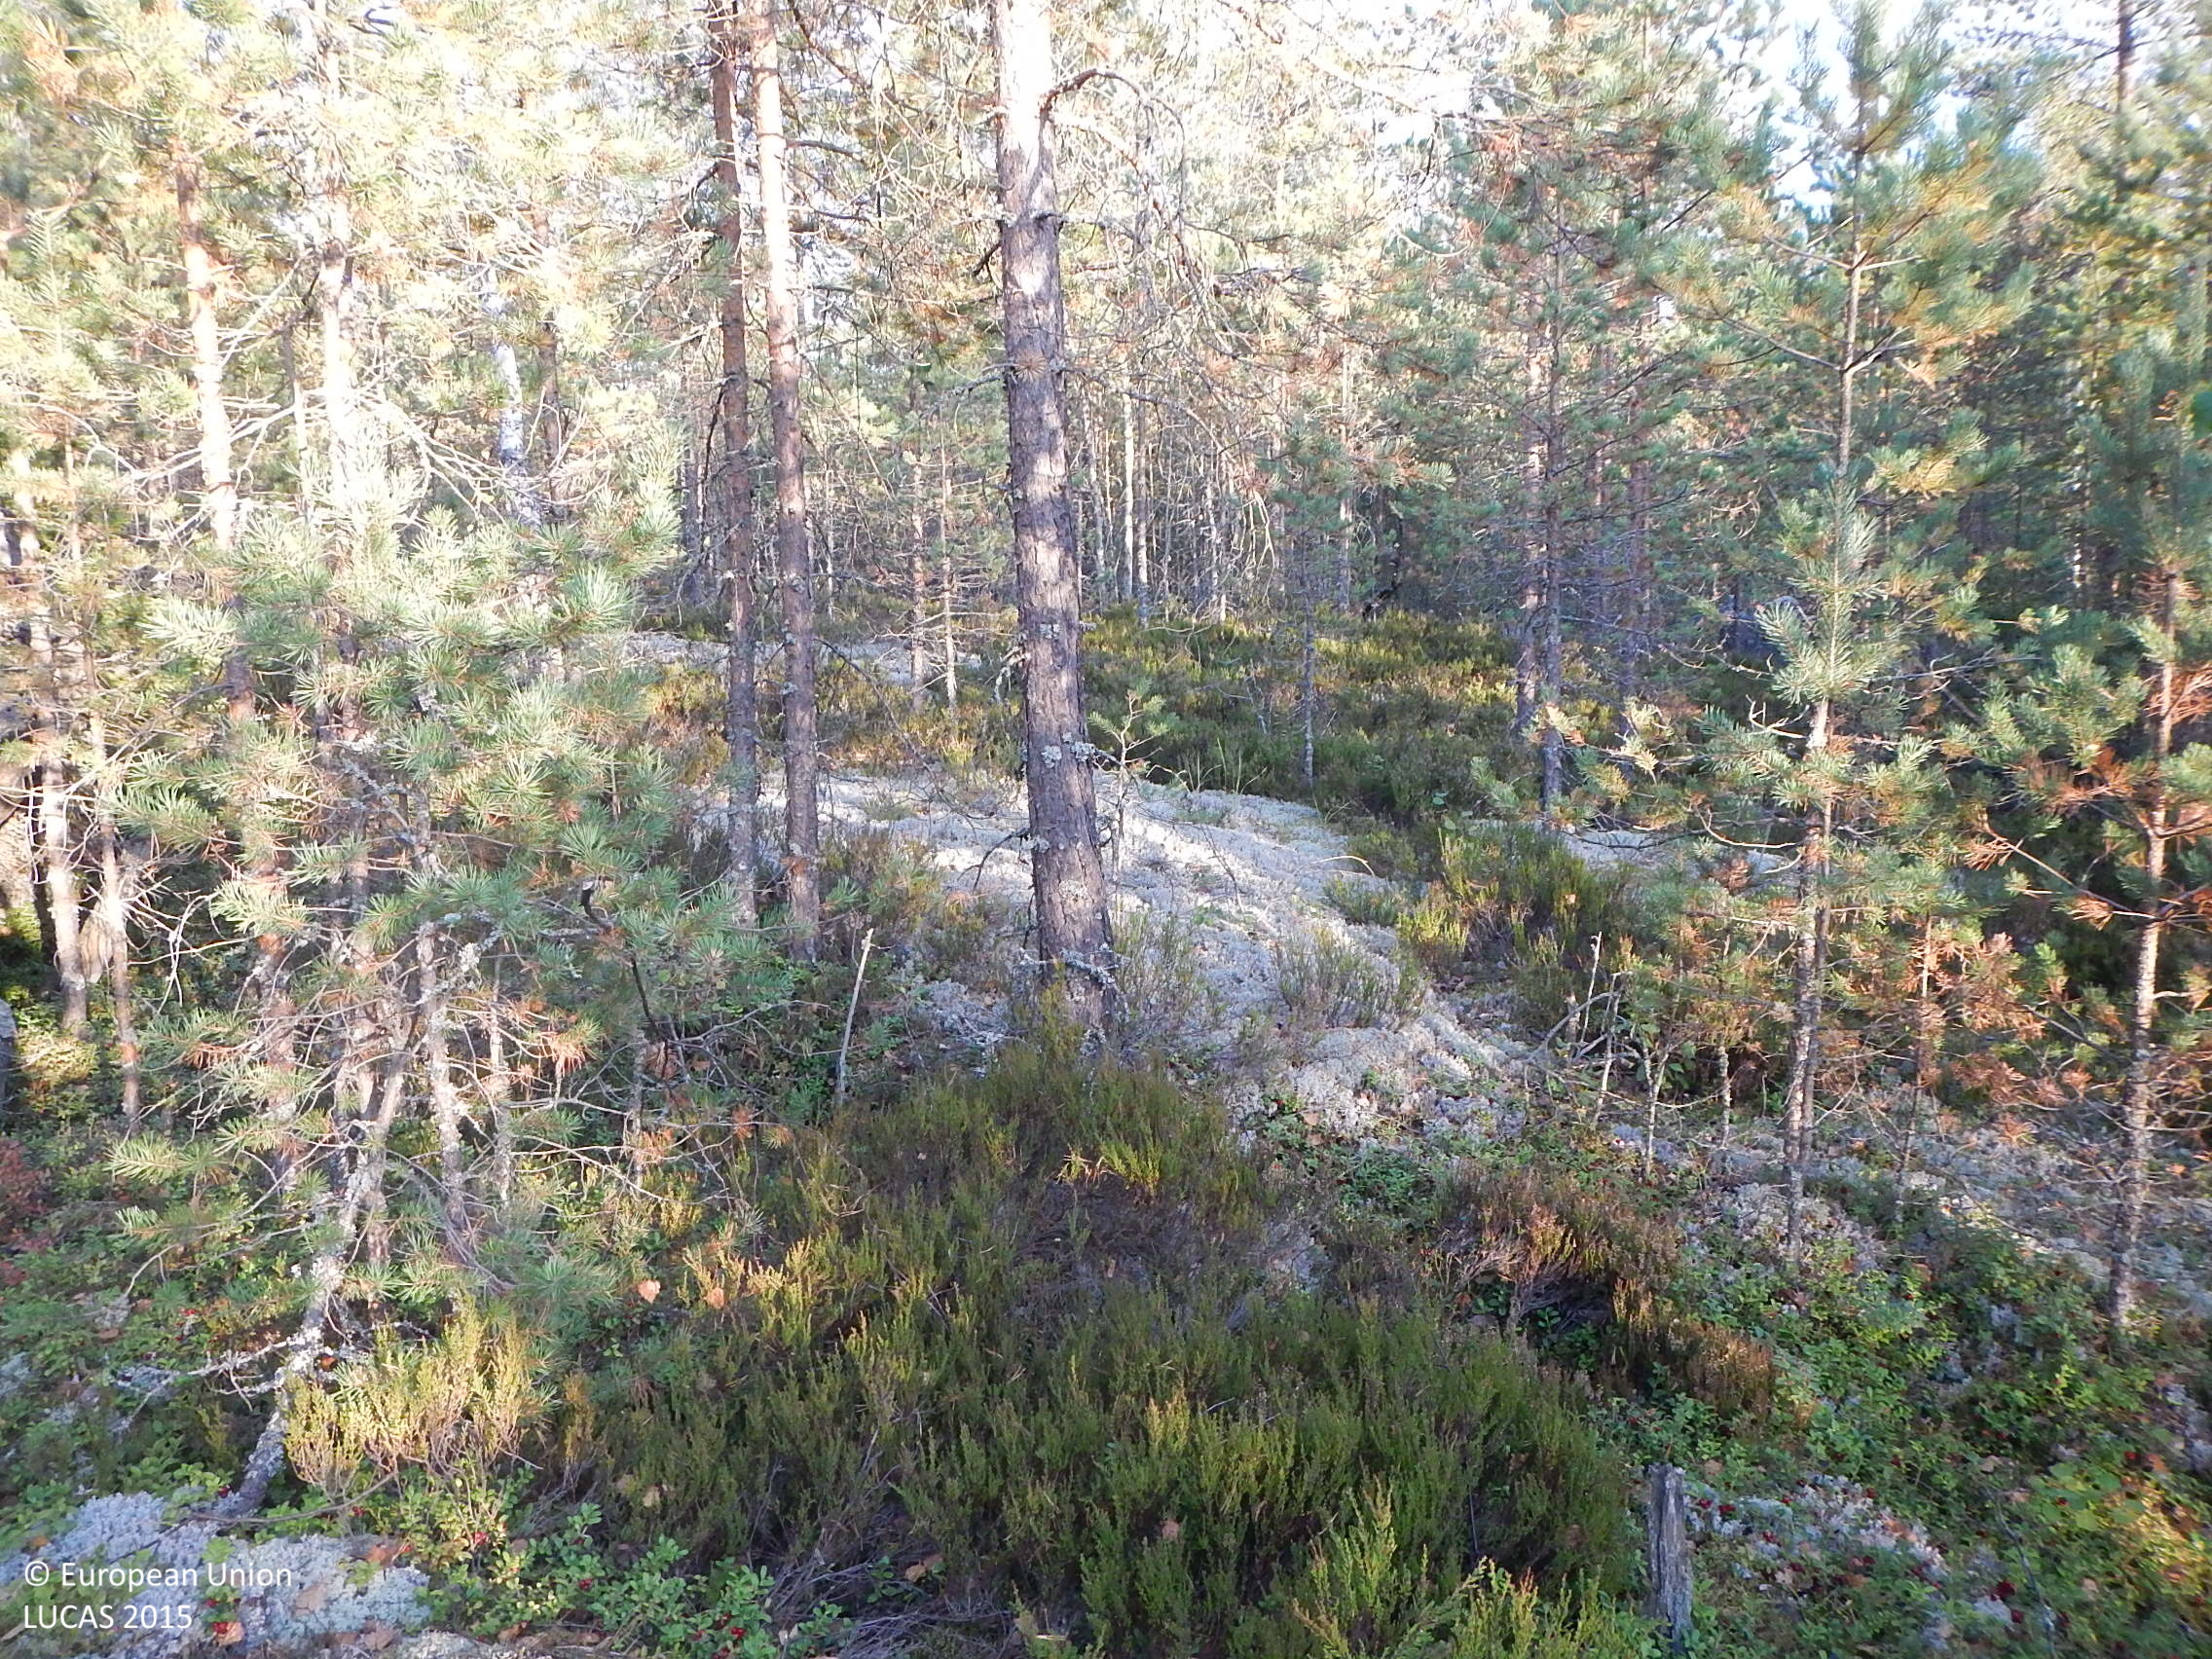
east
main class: Woodland
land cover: Pine dominated coniferous woodland
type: boreal forest
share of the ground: 25 - 50 %
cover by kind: coniferous forest trees 40 %, lichens and mosses 30 %, shrubs 15 %, consolidated bare surface 10 %, broadleaved forest trees 5 %
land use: Forestry
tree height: > 5 m
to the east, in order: Pine dominated coniferous woodland; Rocks and stones; Pine dominated coniferous woodland; Rock outcrops; Pine dominated coniferous woodland; Other coniferous woodland
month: September
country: FI
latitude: 61.5511
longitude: 22.1580
